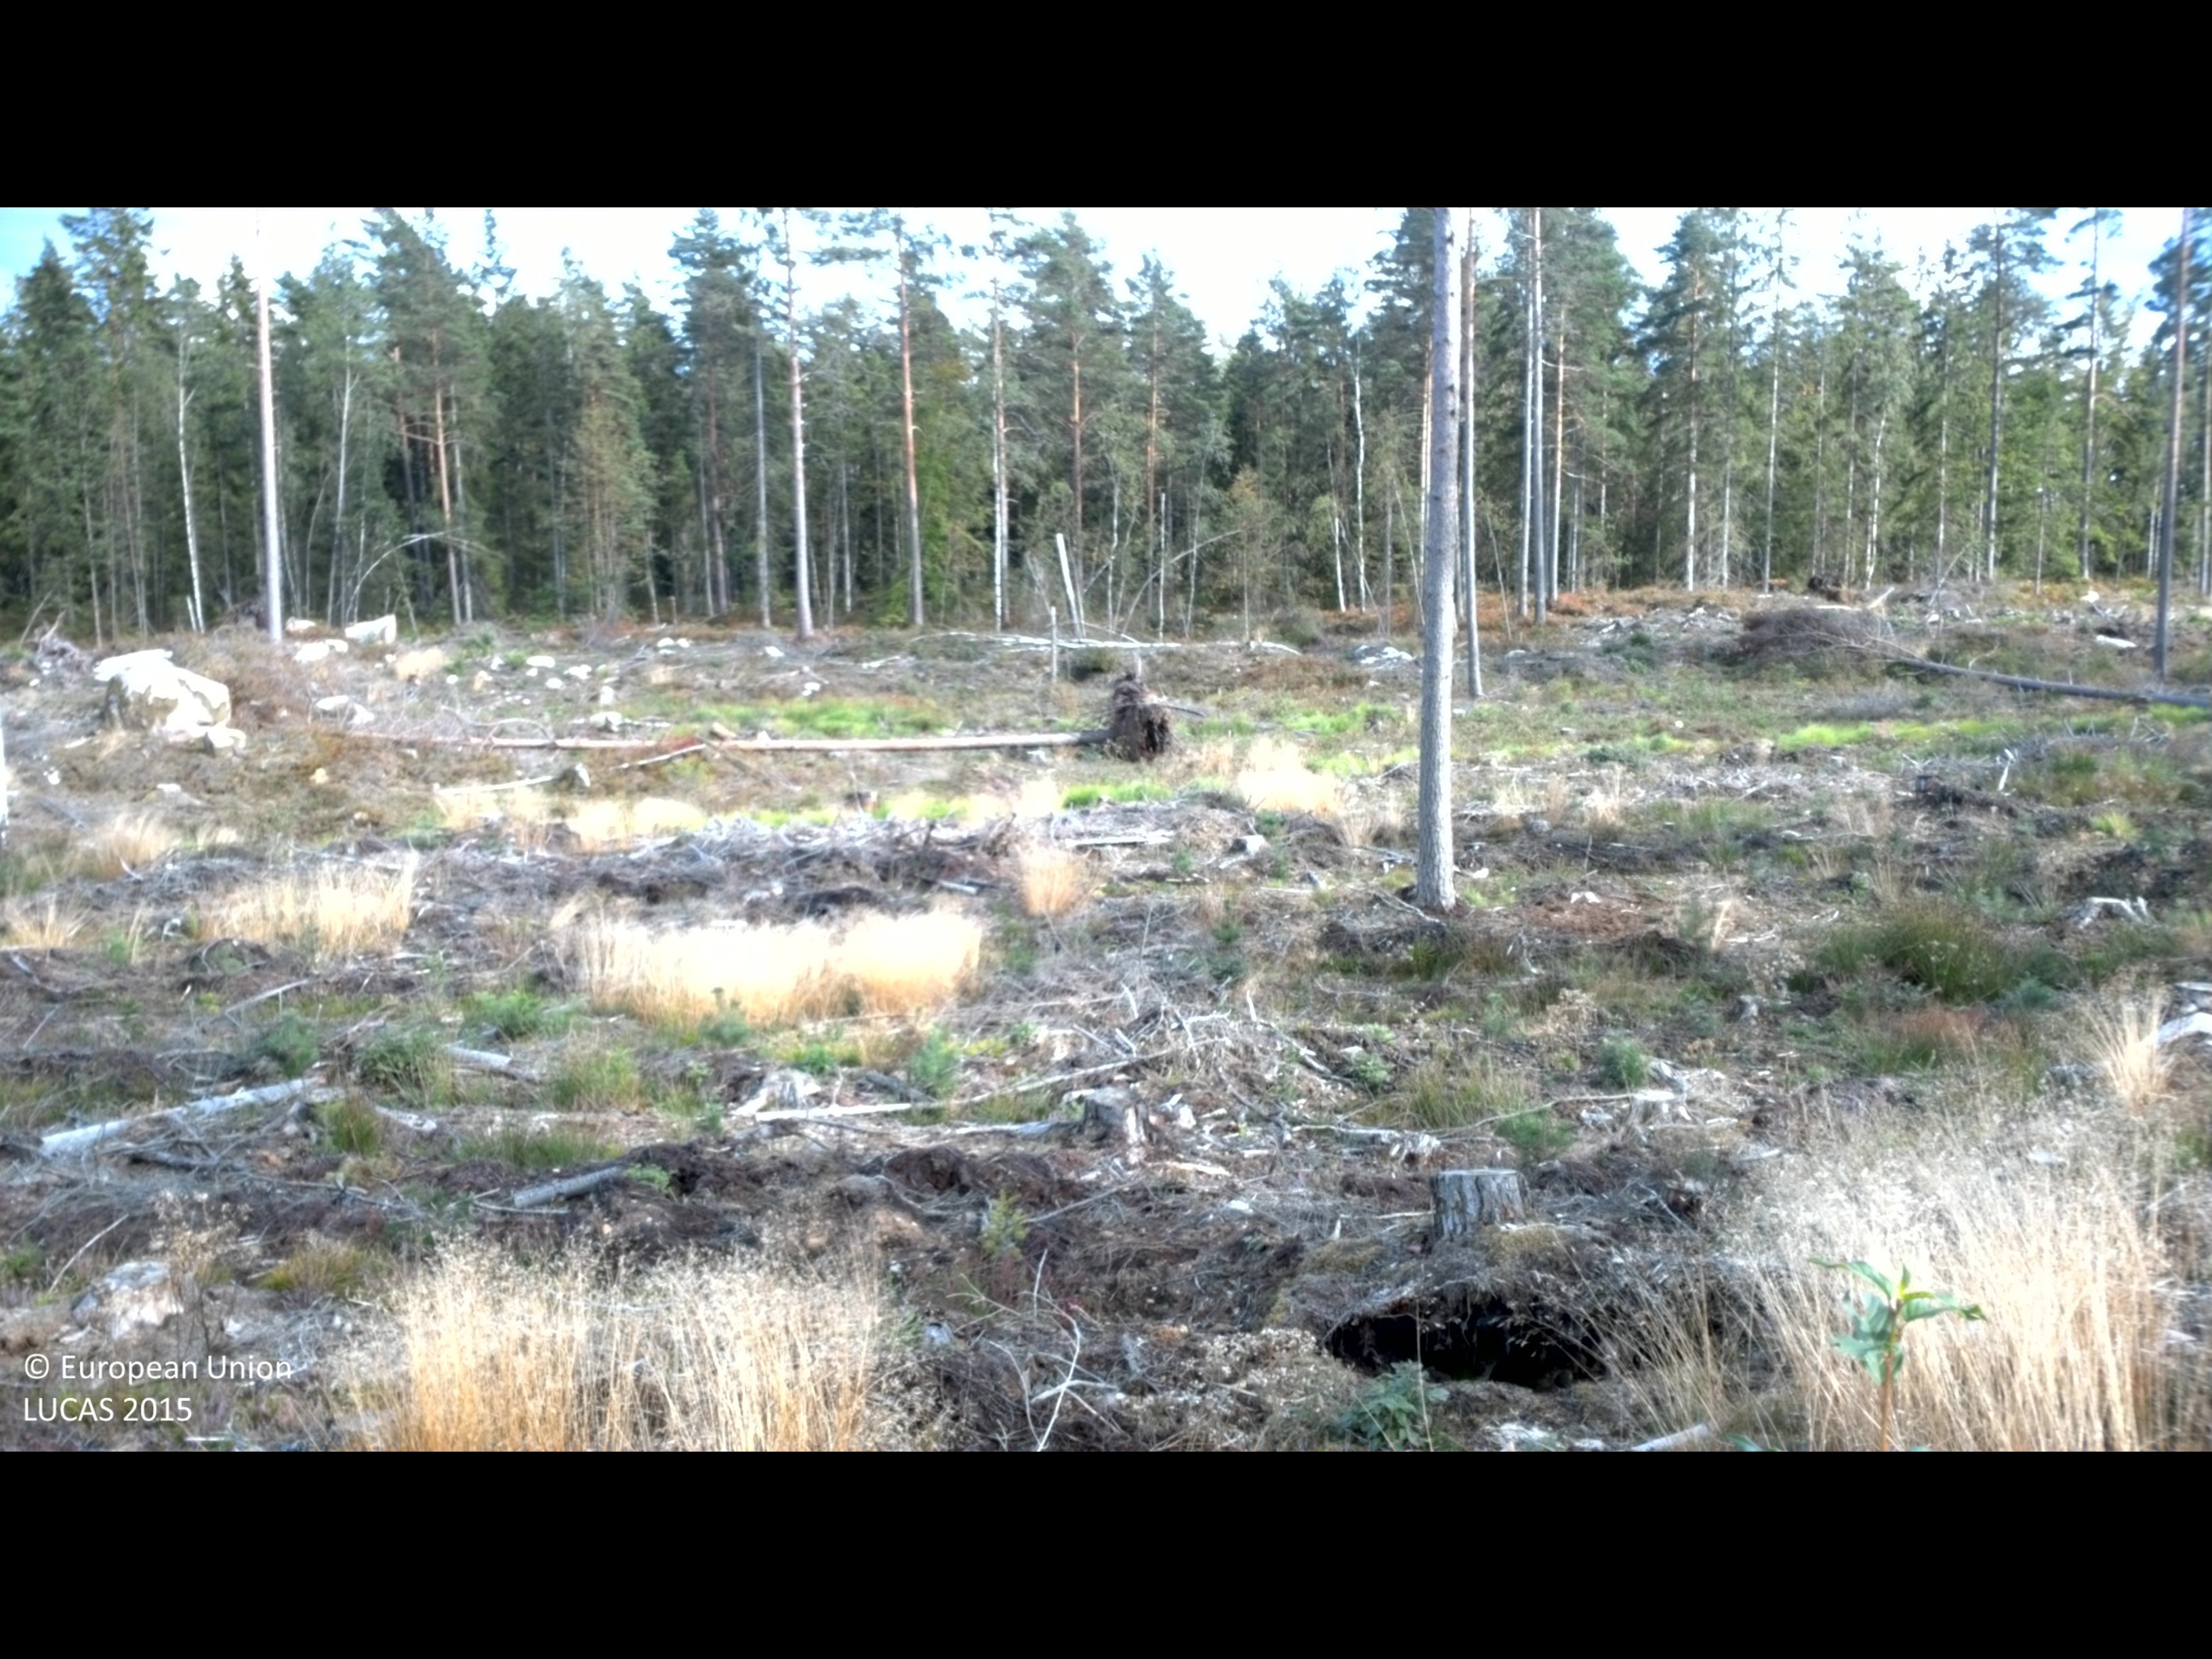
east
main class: Grassland
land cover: Spontaneously vegetated surfaces
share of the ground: 50 - 75 %
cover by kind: herbaceous plants 75 %, shrubs 5 %, lichens and mosses 5 %, consolidated bare surface 5 %, unconsolidated bare surface 5 %
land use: Forestry
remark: Clear cut
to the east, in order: Spontaneously vegetated surfaces; Dry stone walls; Spontaneously vegetated surfaces; Ditches and canals; Spontaneously vegetated surfaces; Spruce dominated coniferous woodland; Tracks; Spruce dominated coniferous woodland; Pine dominated coniferous woodland; Dry stone walls; Broadleaved woodland
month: September
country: SE
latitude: 56.3069
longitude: 14.9929
